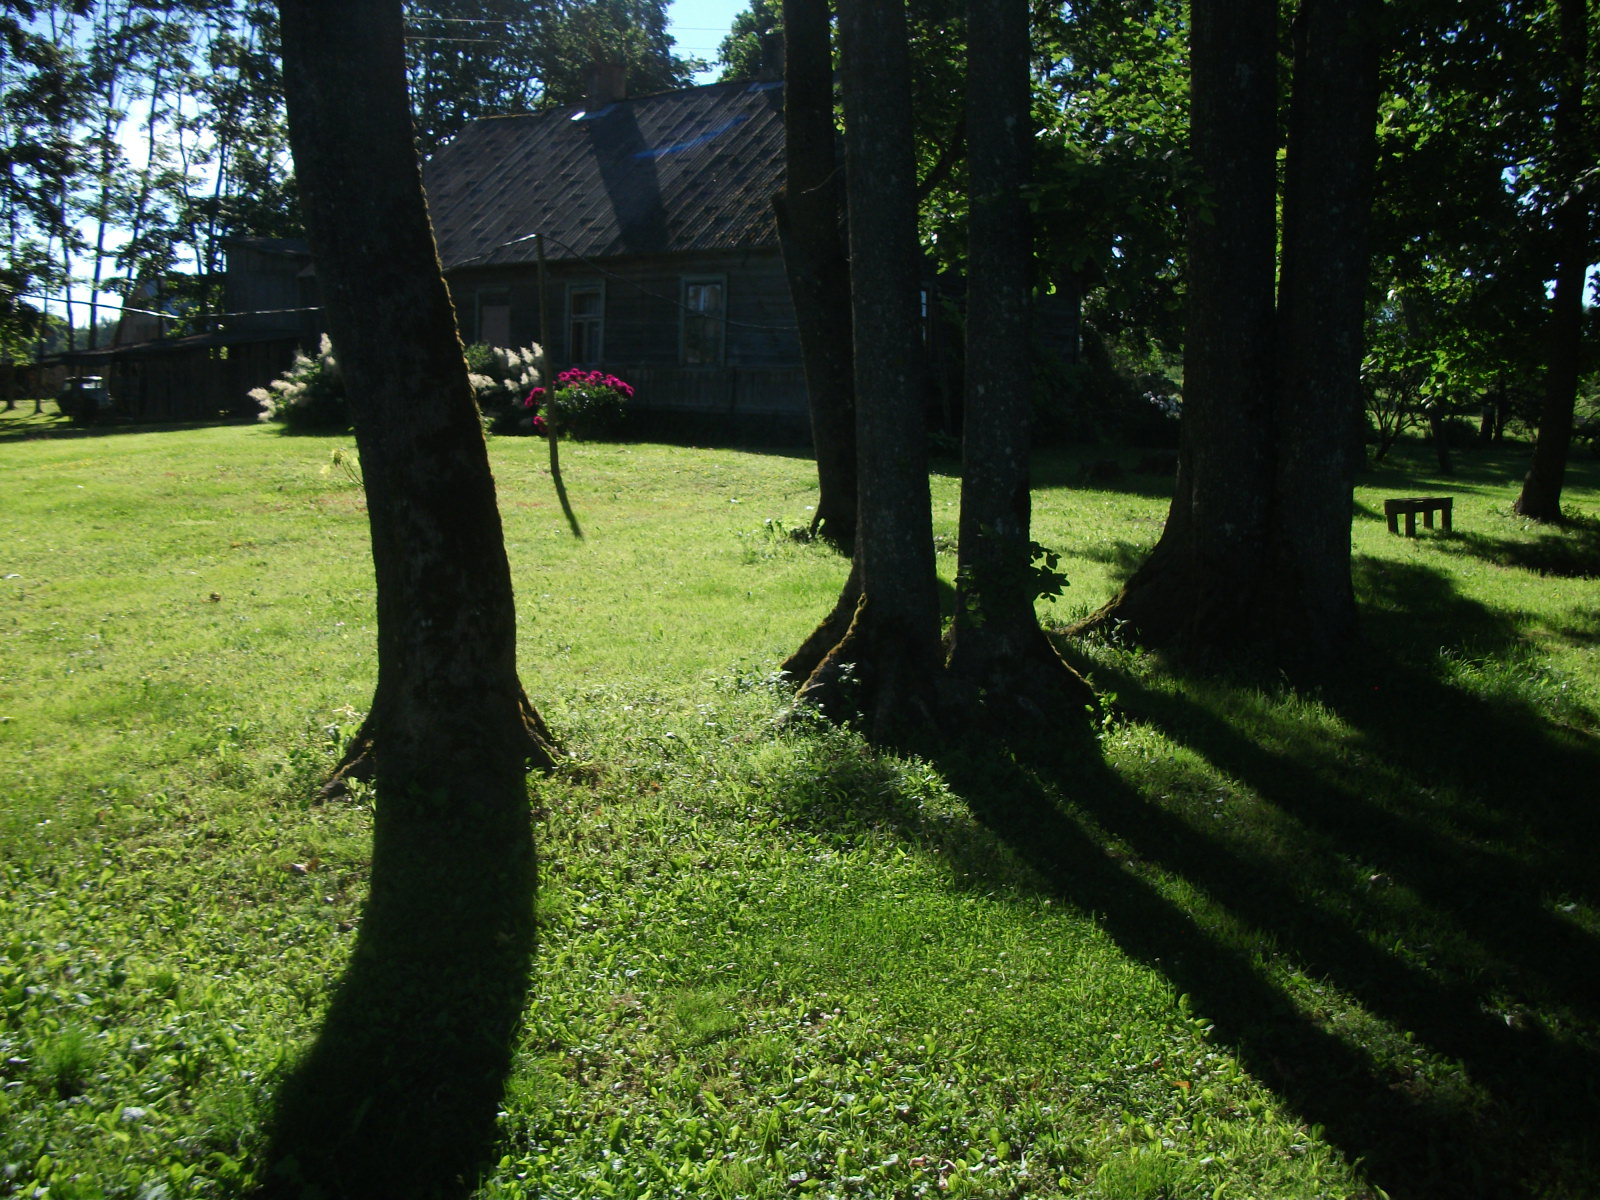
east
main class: Woodland
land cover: Broadleaved woodland
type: non-riverine alder, birch or aspen forest
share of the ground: > 75 %
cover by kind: broadleaved forest trees 85 %, unconsolidated bare surface 15 %
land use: Residential
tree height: > 5 m
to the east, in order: Broadleaved woodland; Artificial constructions in urban areas; Grassland without tree/shrub cover; Electric lines; Grassland without tree/shrub cover; Barley
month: July
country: LV
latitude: 56.7062
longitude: 26.0936
